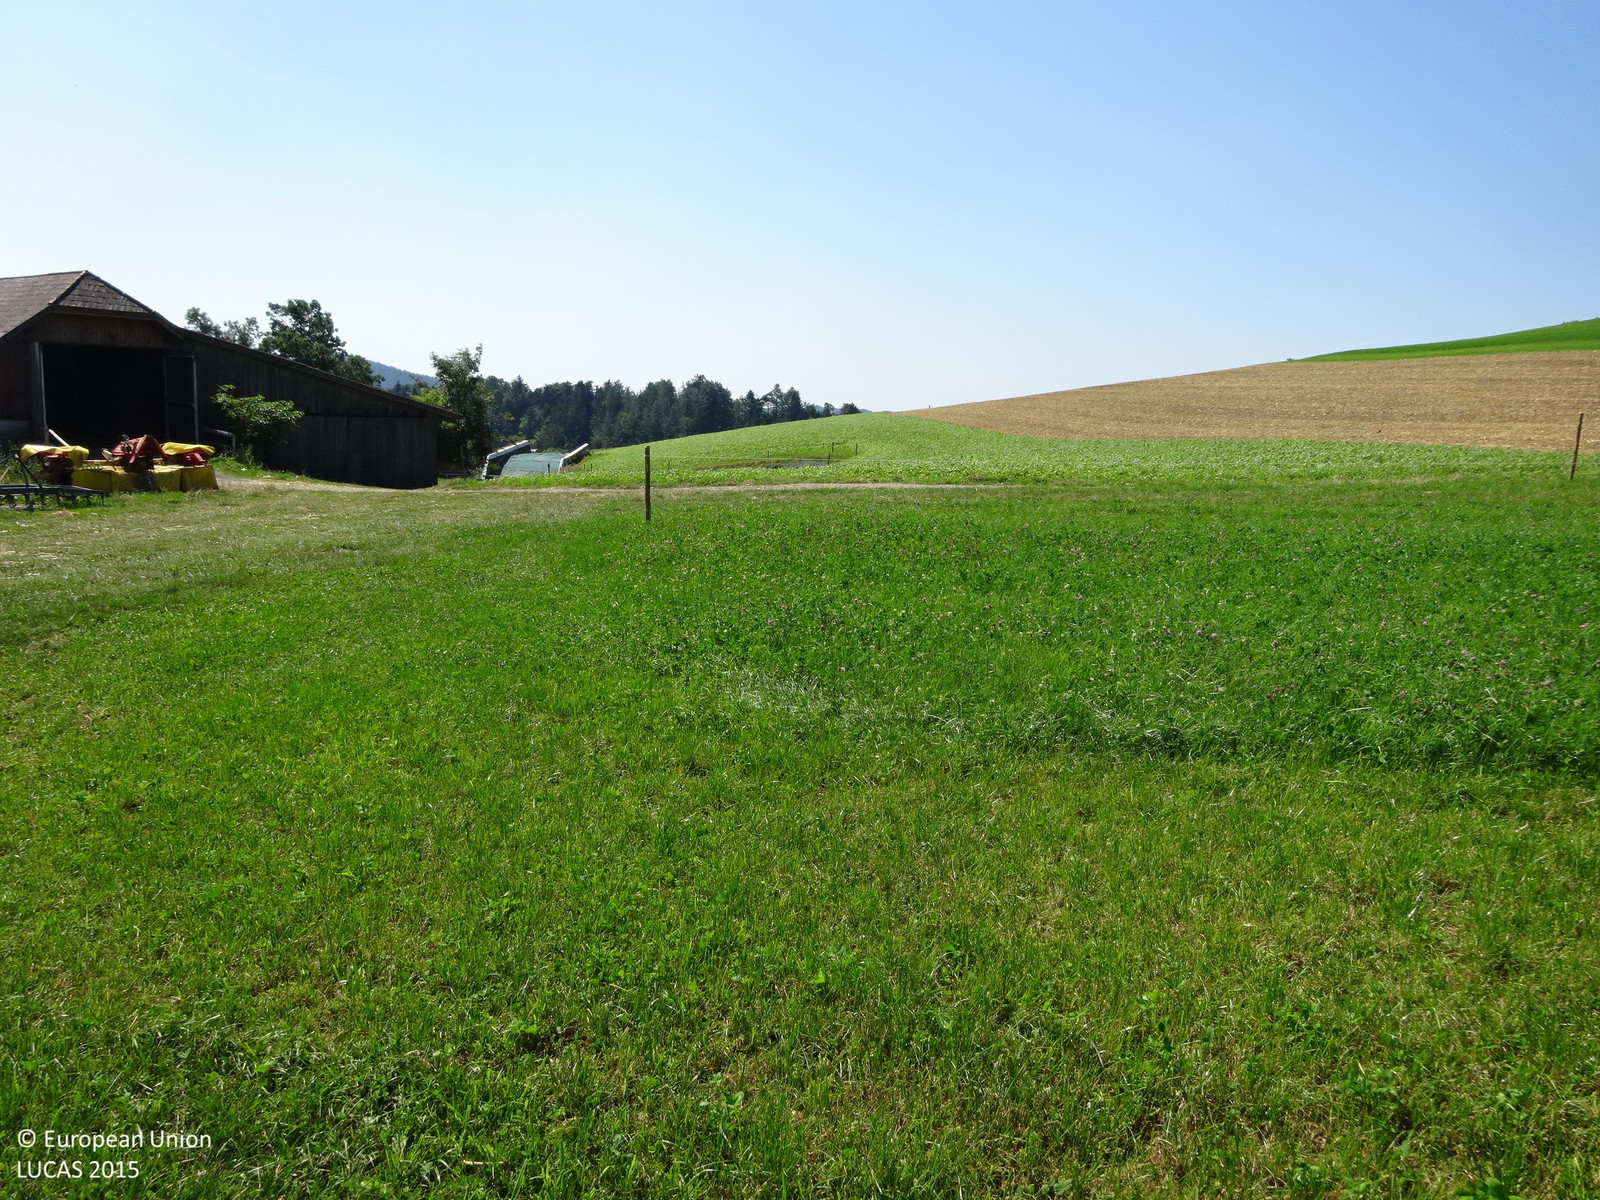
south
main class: Cropland
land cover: Temporary grasslands
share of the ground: > 75 %
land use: Agriculture (excluding fallow land and kitchen gardens)
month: August
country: AT
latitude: 47.4939
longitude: 16.1217
